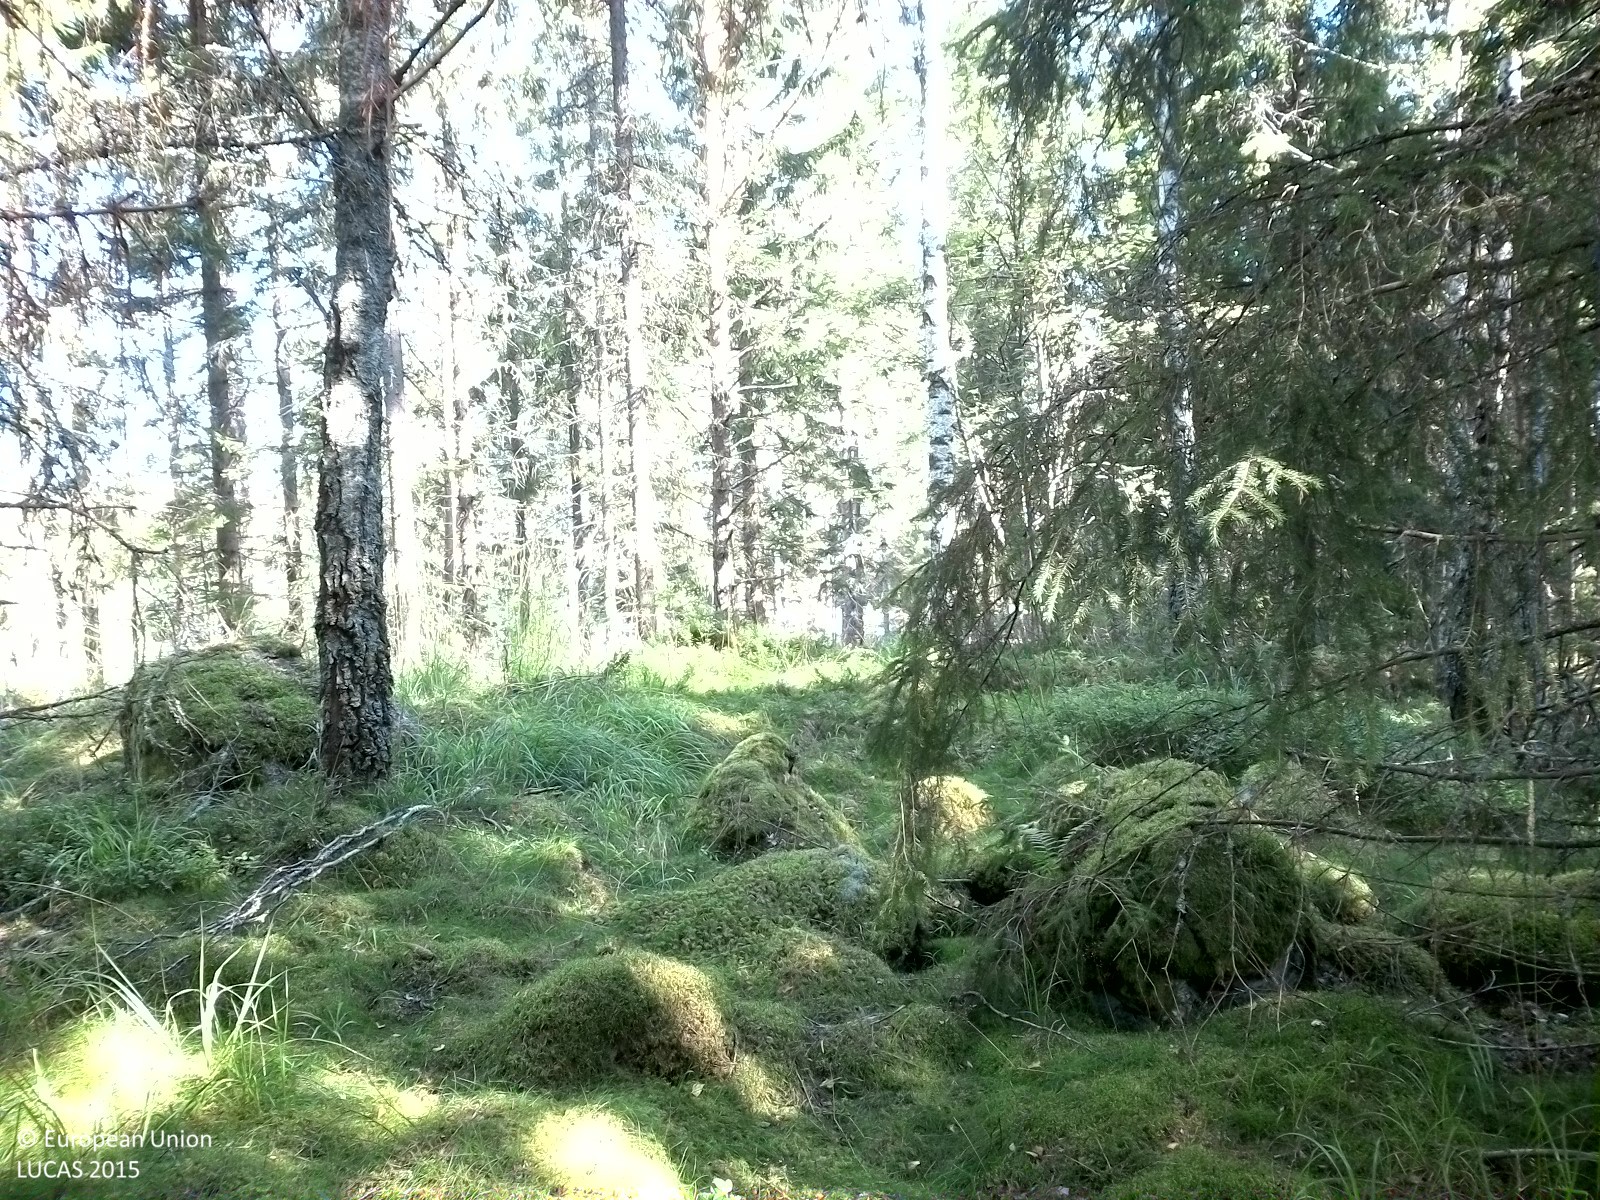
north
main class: Woodland
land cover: Spruce dominated mixed woodland
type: boreal forest
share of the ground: 50 - 75 %
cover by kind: coniferous forest trees 35 %, lichens and mosses 30 %, broadleaved forest trees 15 %, herbaceous plants 15 %, shrubs 5 %
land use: Forestry
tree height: > 5 m
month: August
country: SE
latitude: 58.7746
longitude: 15.0257
